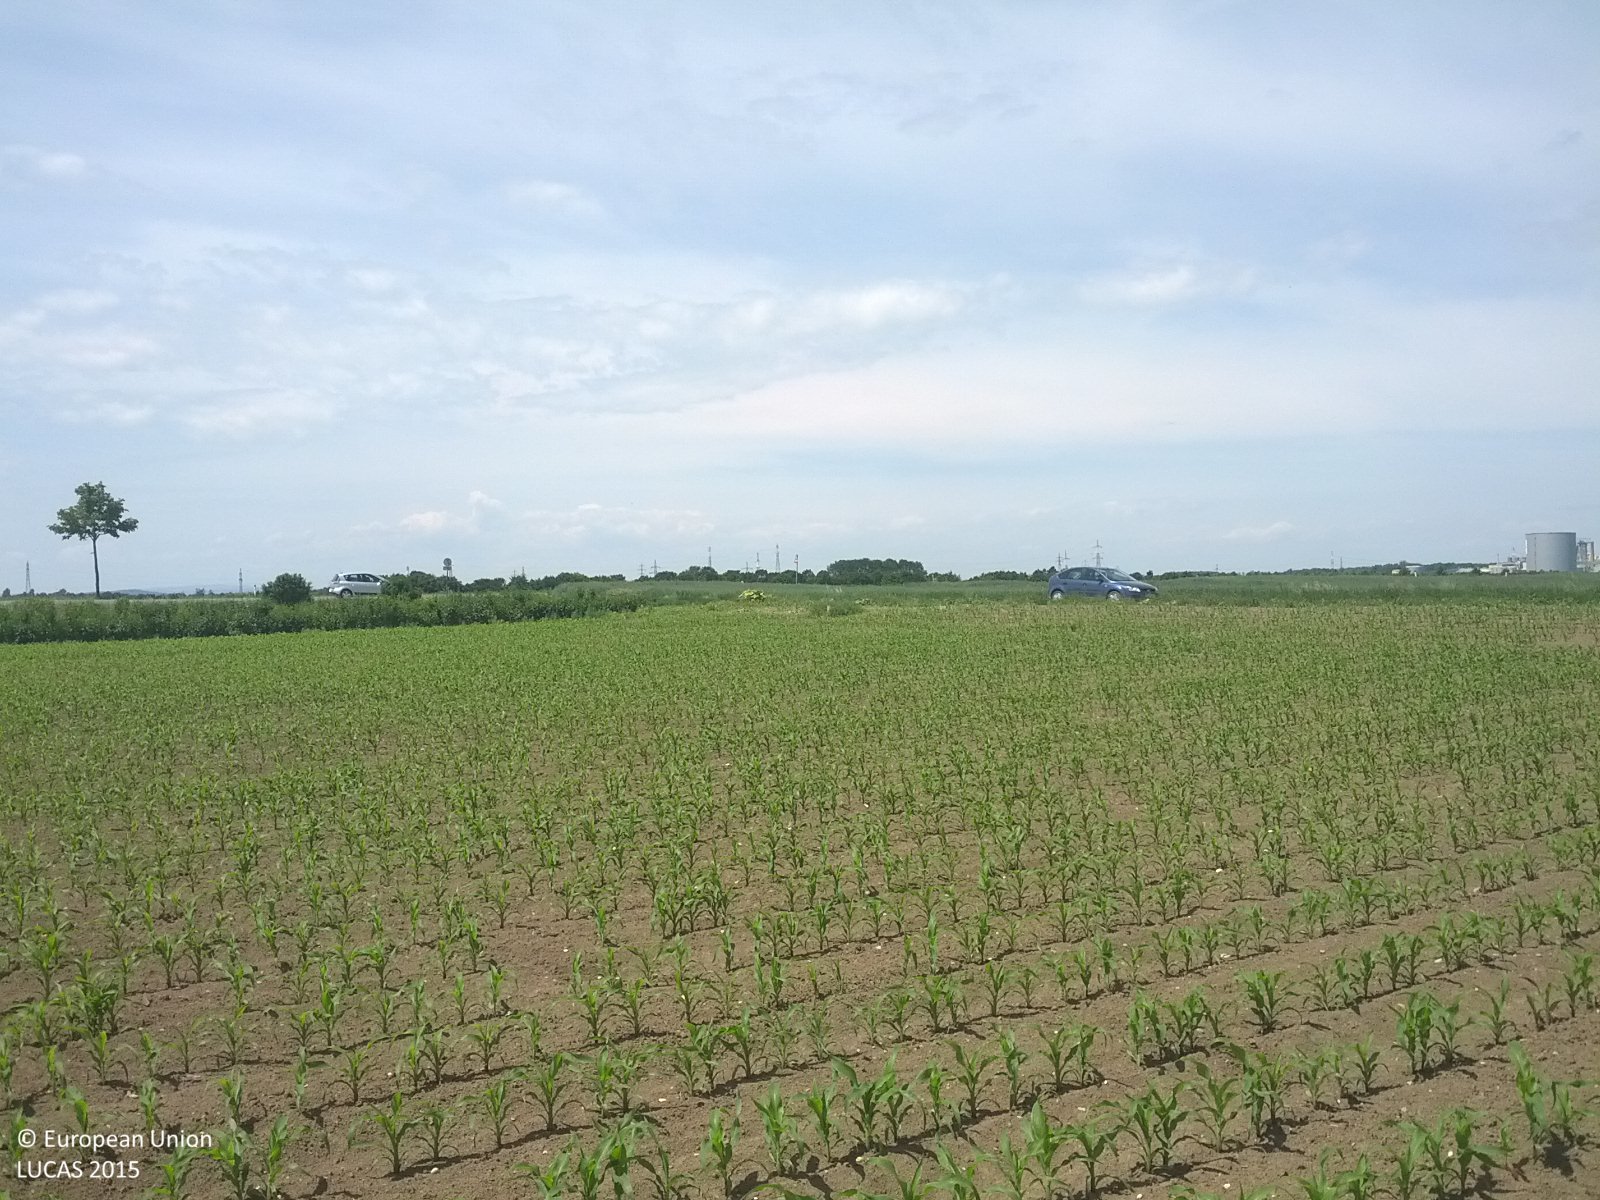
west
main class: Cropland
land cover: Maize
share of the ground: 10 - 25 %
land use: Agriculture (excluding fallow land and kitchen gardens)
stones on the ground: < 10 %
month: May
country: AT
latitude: 48.3096
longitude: 16.0581
